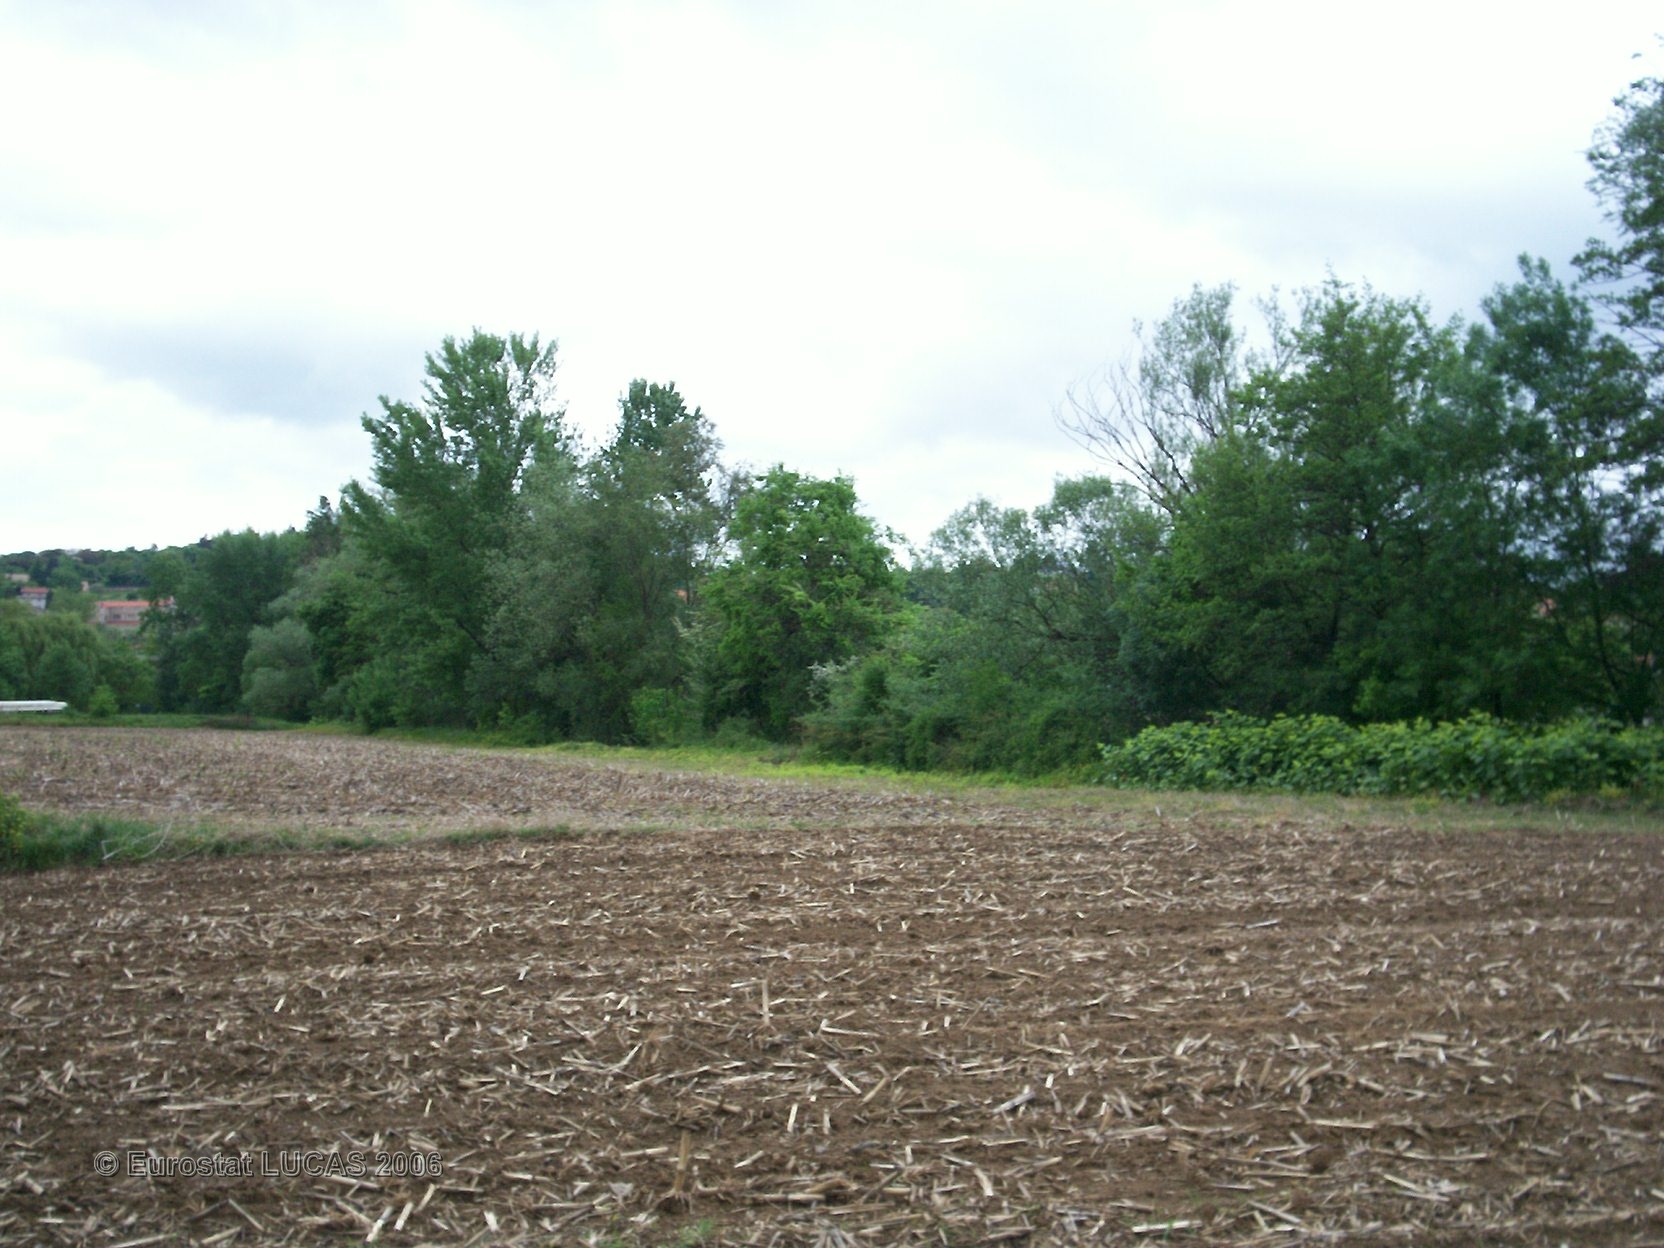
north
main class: Cropland
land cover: Maize
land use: Agriculture (excluding fallow land and kitchen gardens)
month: May
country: FR
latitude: 45.9350
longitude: 4.7797
